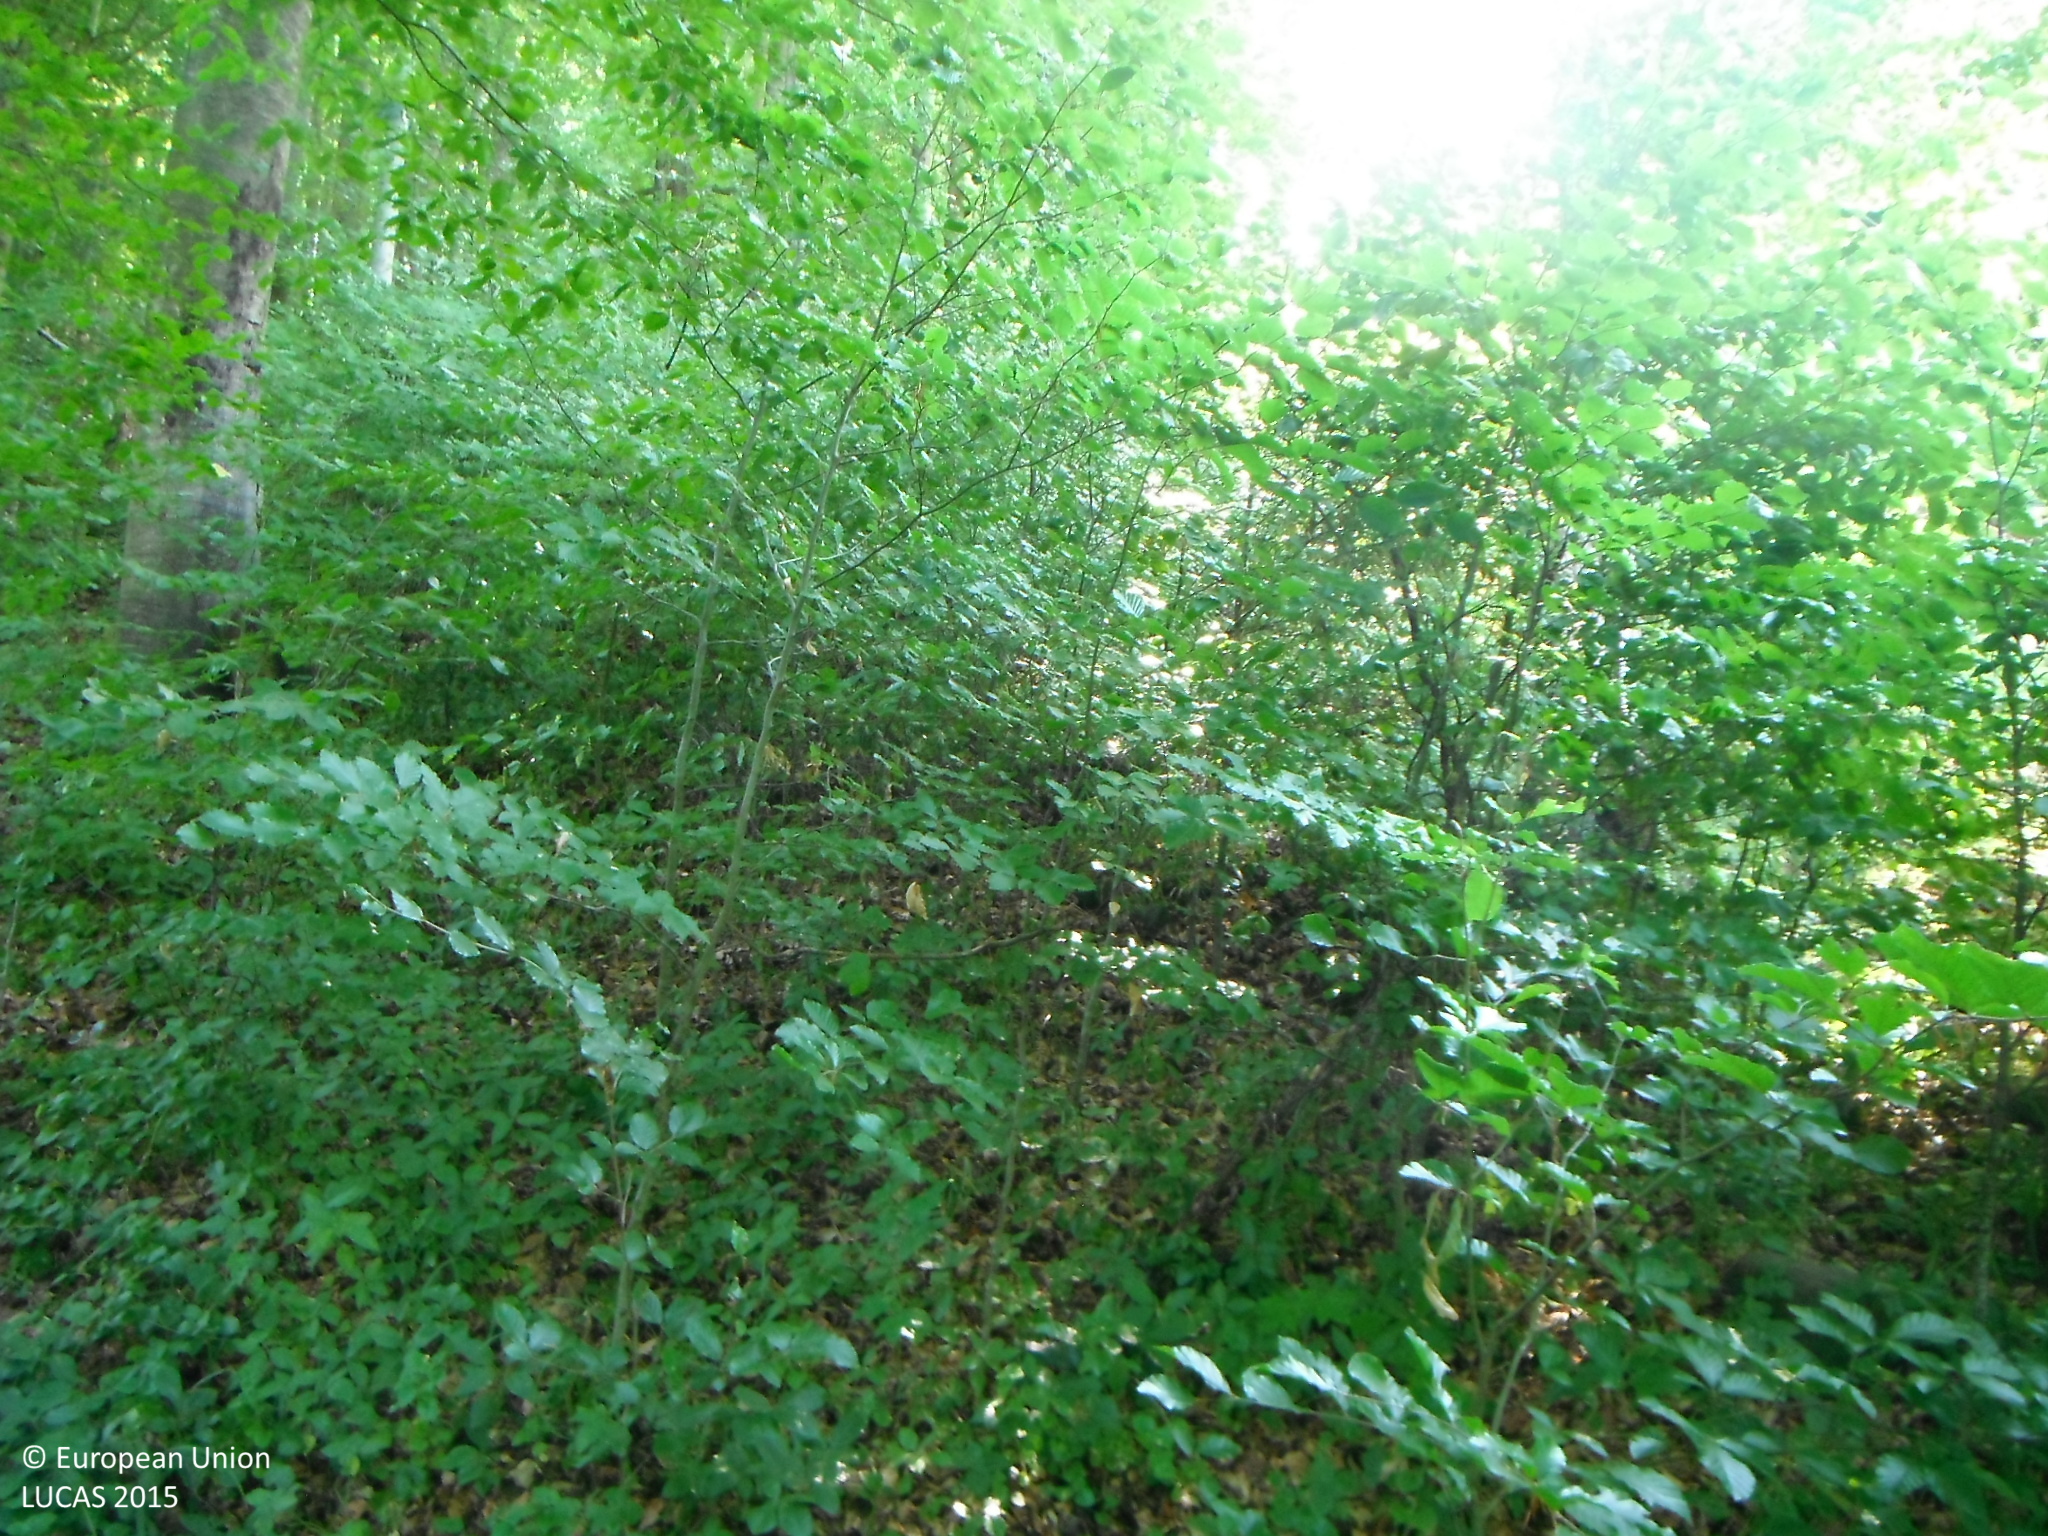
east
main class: Woodland
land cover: Broadleaved woodland
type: beech forest
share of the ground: > 75 %
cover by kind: broadleaved forest trees 90 %, herbaceous plants 10 %
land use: Forestry
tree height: > 5 m
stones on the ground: 25 - 50 %
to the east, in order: Broadleaved woodland; Tracks; Broadleaved woodland
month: July
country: SK
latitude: 48.5271
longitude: 19.1894
